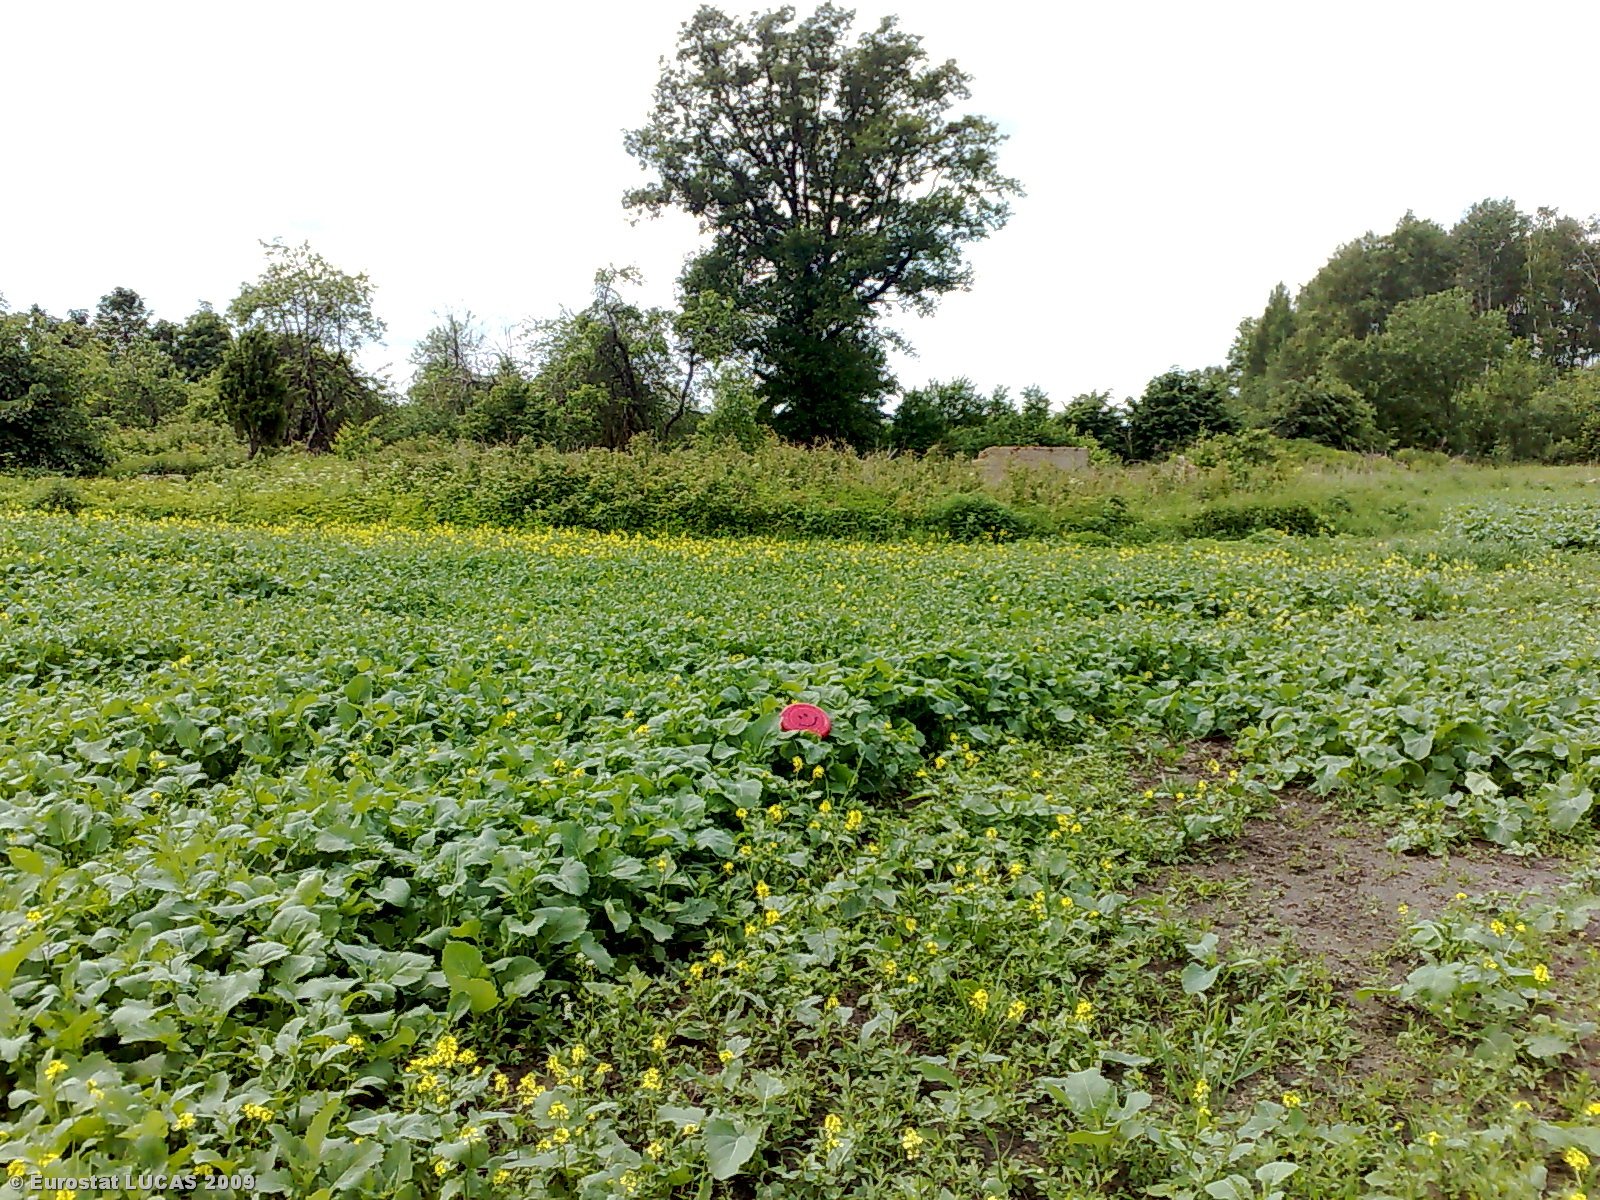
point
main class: Cropland
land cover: Other root crops
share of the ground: > 75 %
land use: Agriculture (excluding fallow land and kitchen gardens)
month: June
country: LT
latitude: 56.1313
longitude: 24.1356
